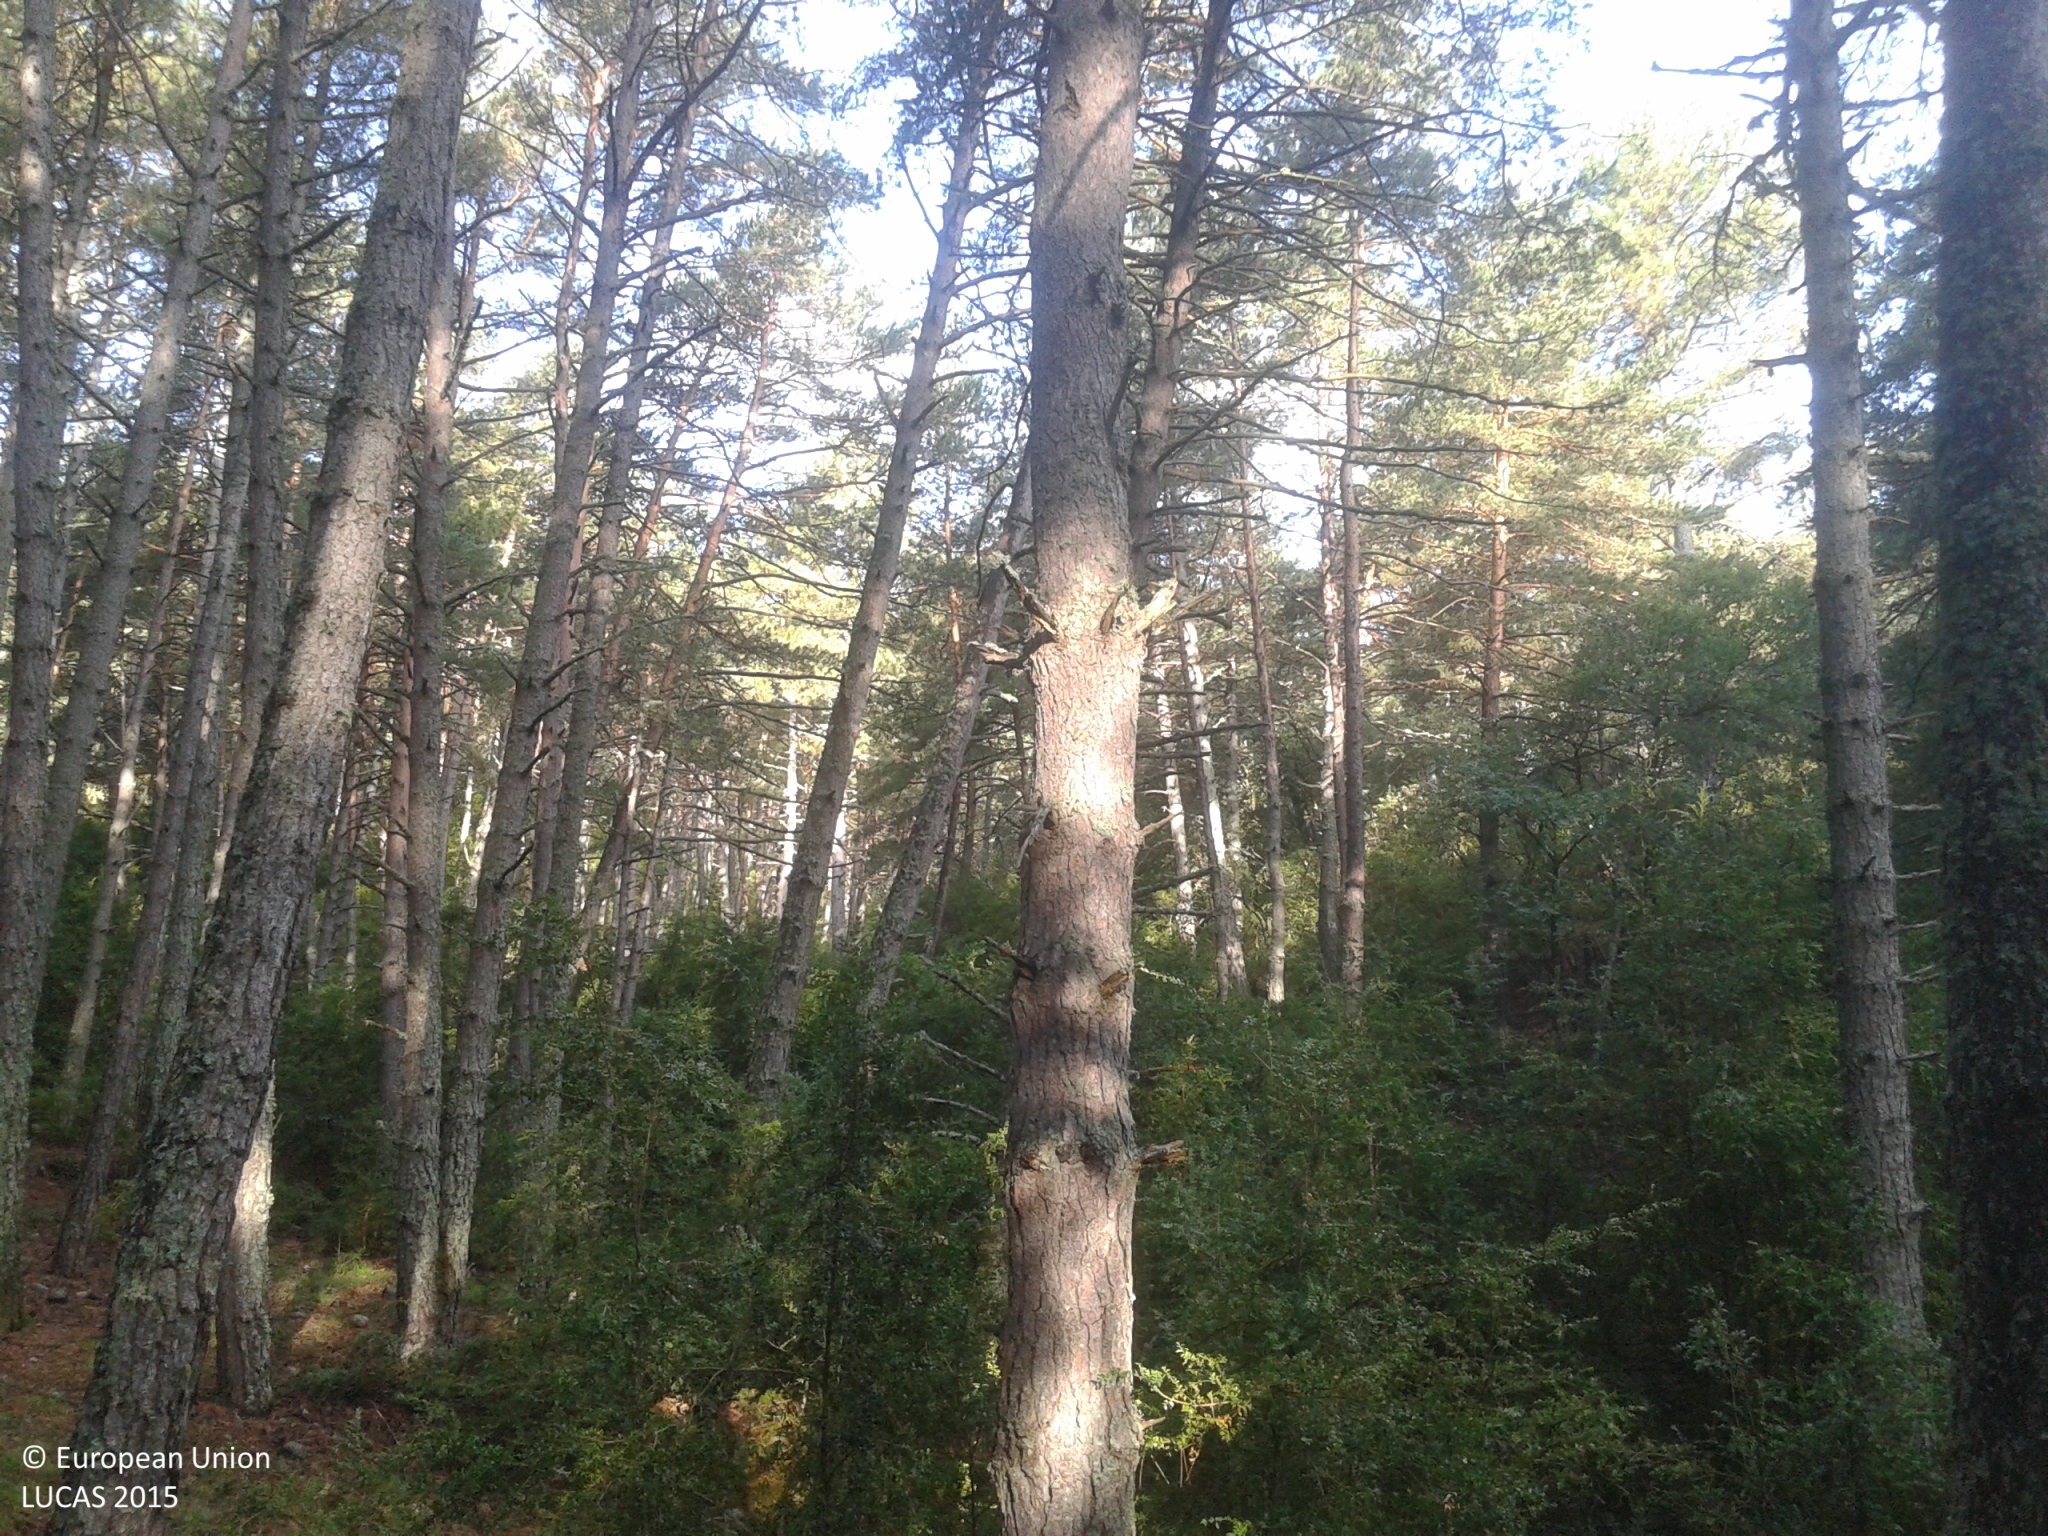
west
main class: Woodland
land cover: Pine dominated coniferous woodland
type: coniferous forest of the mediterranean region
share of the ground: > 75 %
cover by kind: coniferous forest trees 90 %, shrubs 5 %, herbaceous plants 5 %
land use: Forestry
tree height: > 5 m
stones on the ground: > 50 %
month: August
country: ES
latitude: 42.2594
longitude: 1.0751
